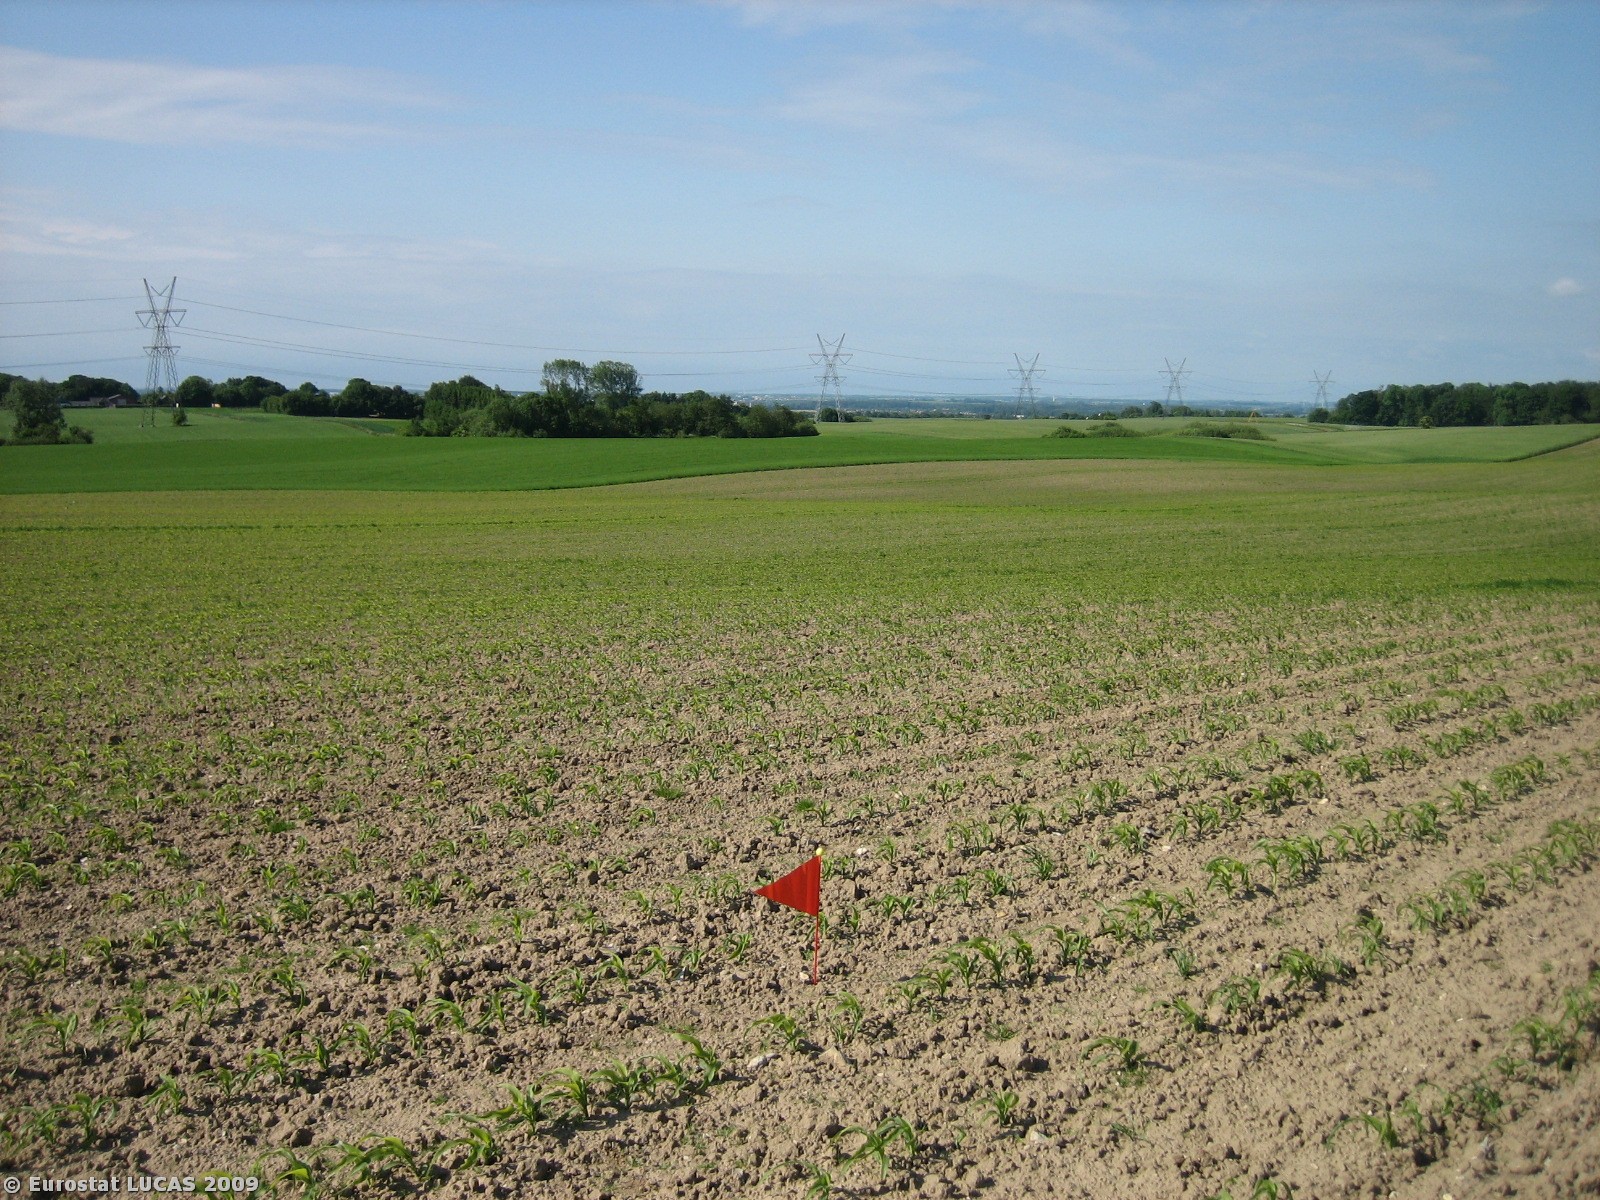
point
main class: Cropland
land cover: Maize
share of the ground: < 10 %
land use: Agriculture (excluding fallow land and kitchen gardens)
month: June
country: DK
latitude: 55.9181
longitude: 9.8881
